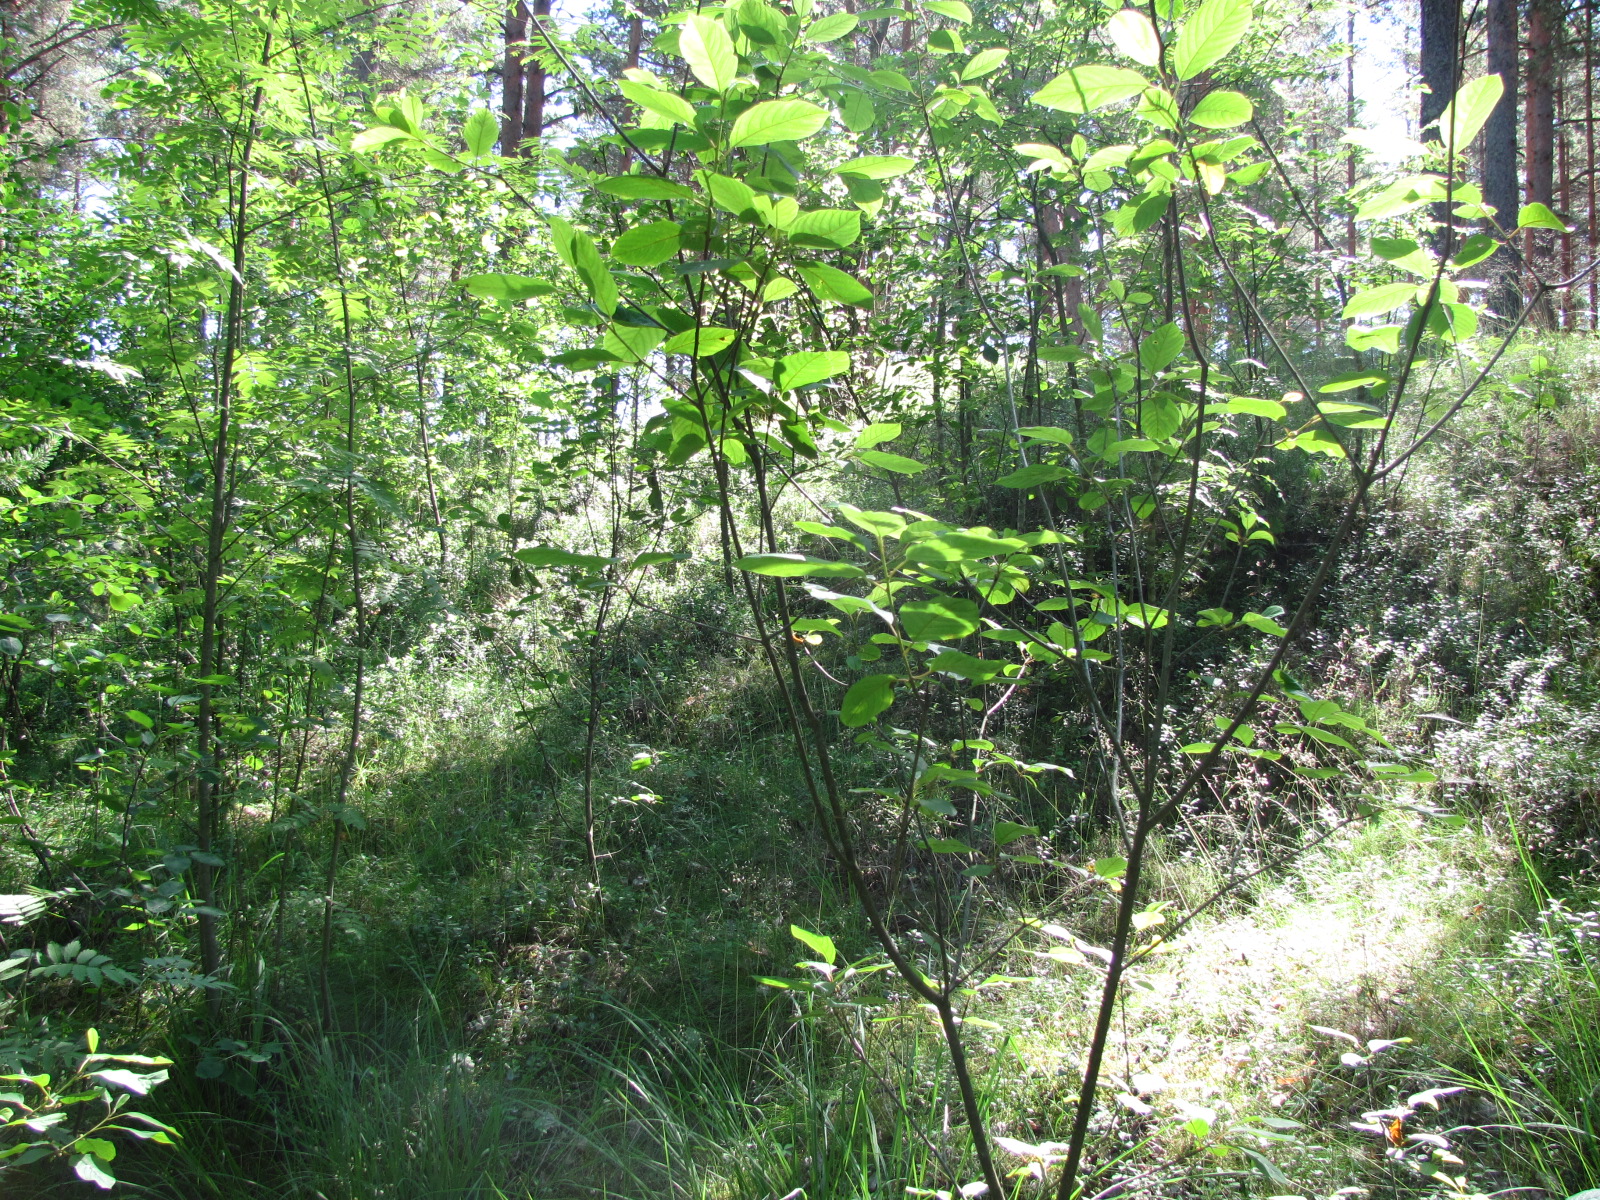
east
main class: Woodland
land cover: Pine dominated mixed woodland
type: hemiboreal forest and nemoral coniferous forest and mixed broadleaved-coniferous forest
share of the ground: > 75 %
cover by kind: coniferous forest trees 45 %, broadleaved forest trees 45 %, herbaceous plants 5 %, lichens and mosses 5 %
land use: Forestry
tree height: > 5 m
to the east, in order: Pine dominated mixed woodland; Pine dominated coniferous woodland; Tracks; Pine dominated coniferous woodland; Tracks; Pine dominated coniferous woodland; Tracks; Pine dominated coniferous woodland
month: July
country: LV
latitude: 56.8833
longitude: 24.1176
